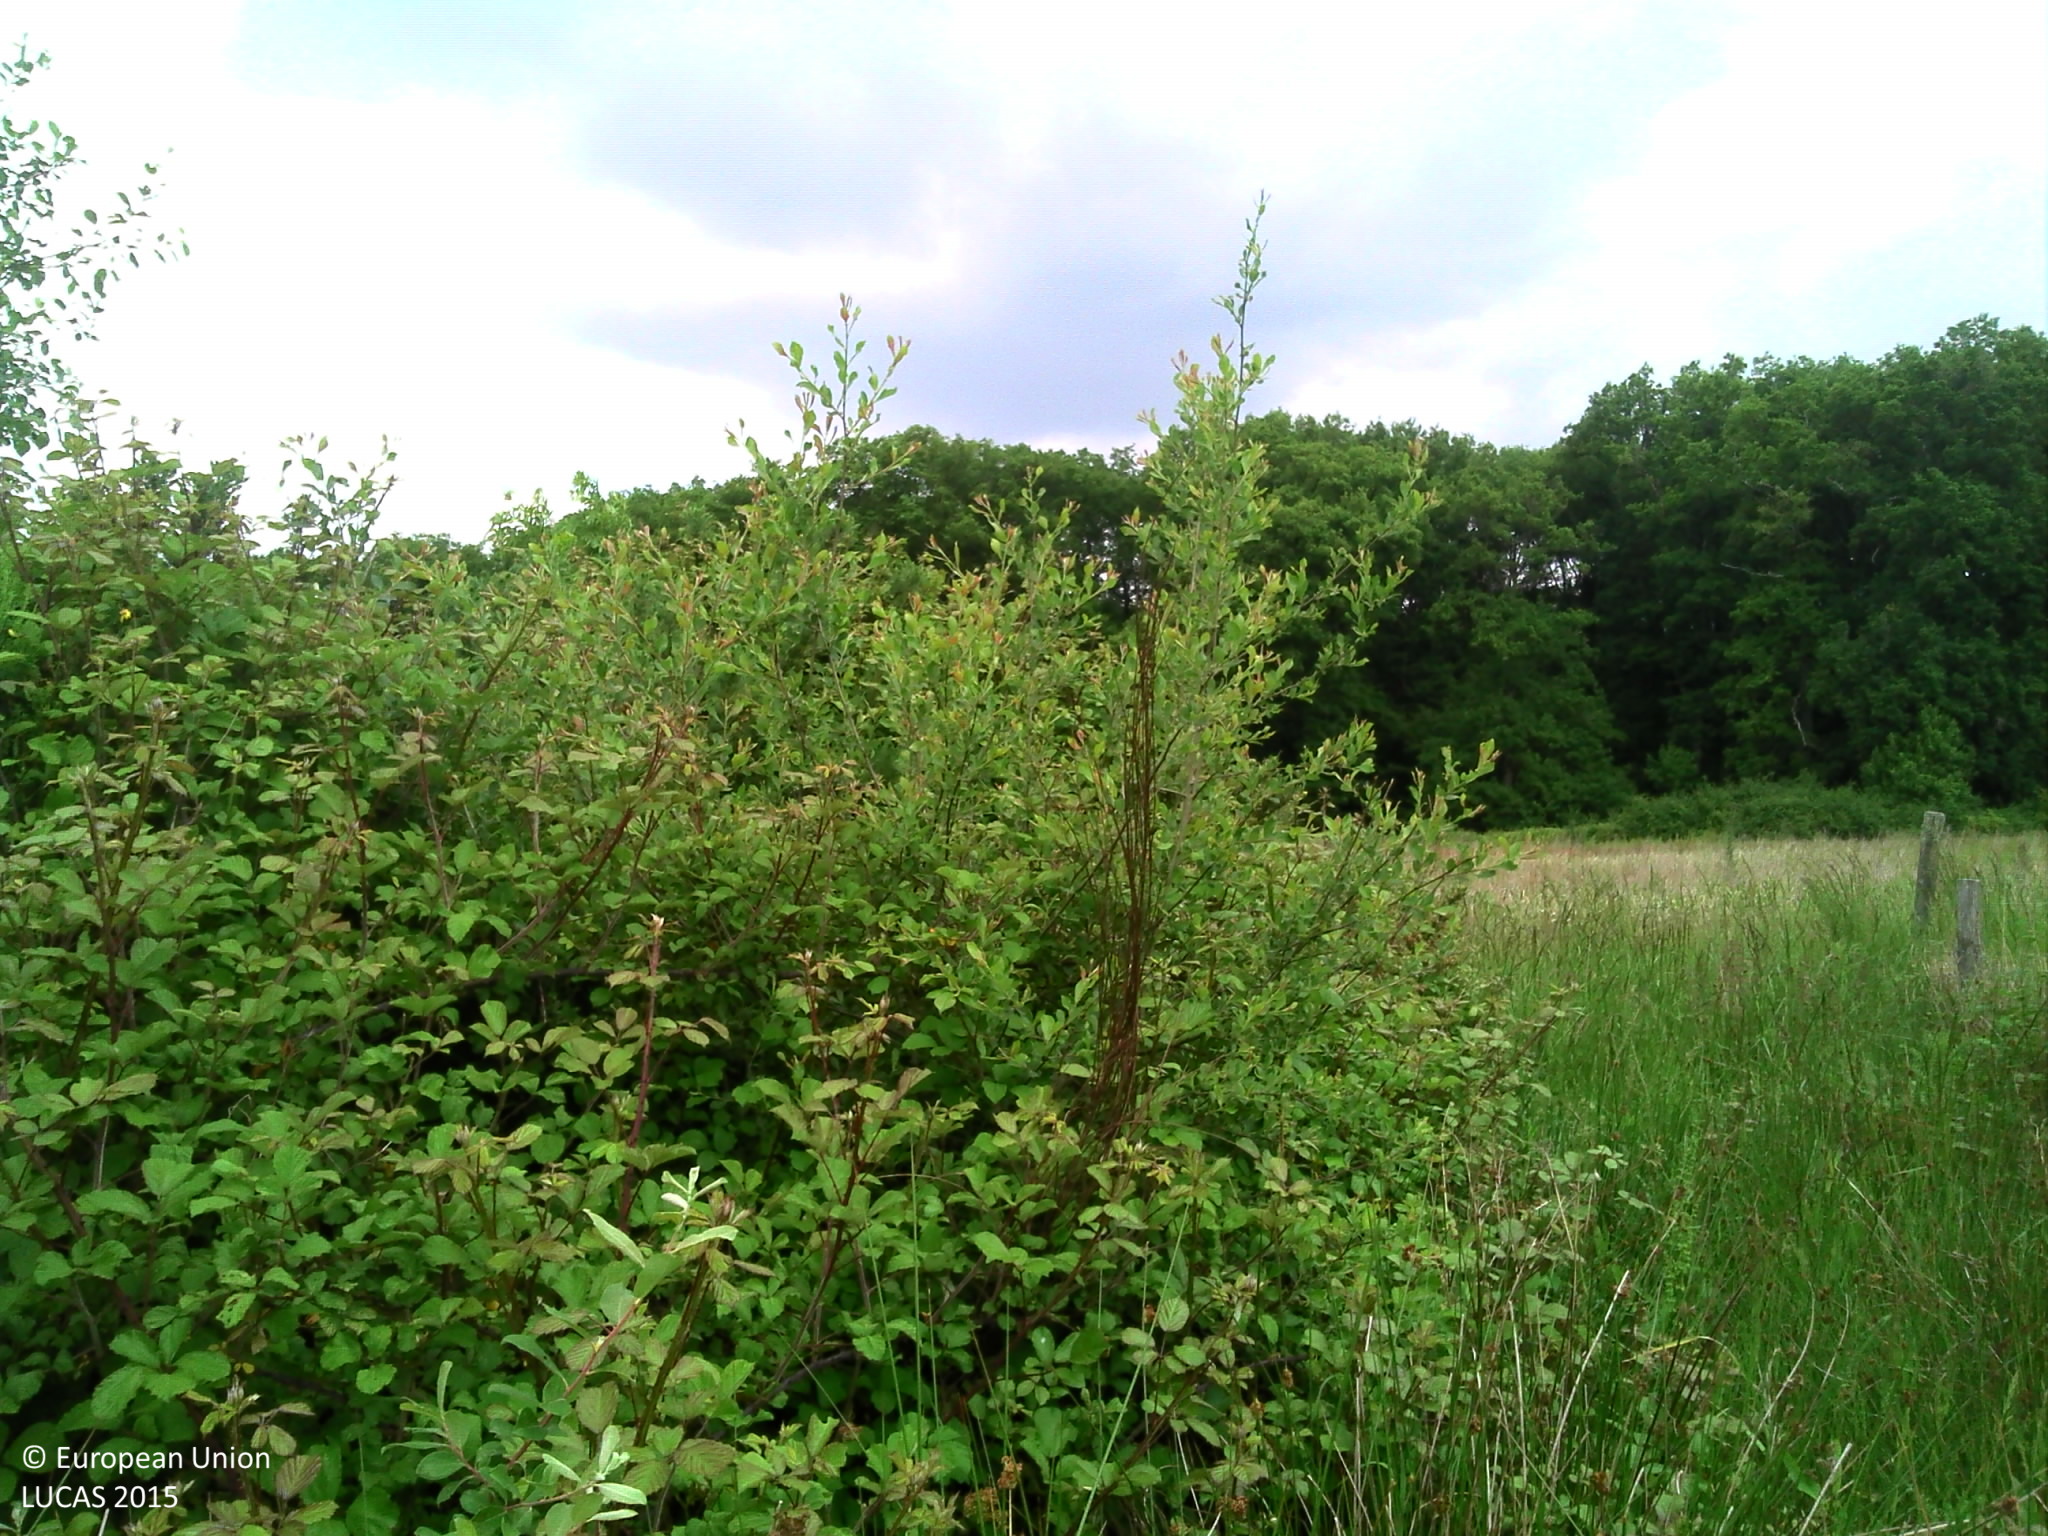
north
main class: Shrubland
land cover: Shrubland with sparse tree cover
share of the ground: > 75 %
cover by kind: shrubs 90 %, broadleaved forest trees 5 %, herbaceous plants 5 %
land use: Abandoned areas
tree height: < 5 m
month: May
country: FR
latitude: 47.5973
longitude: 0.7368
